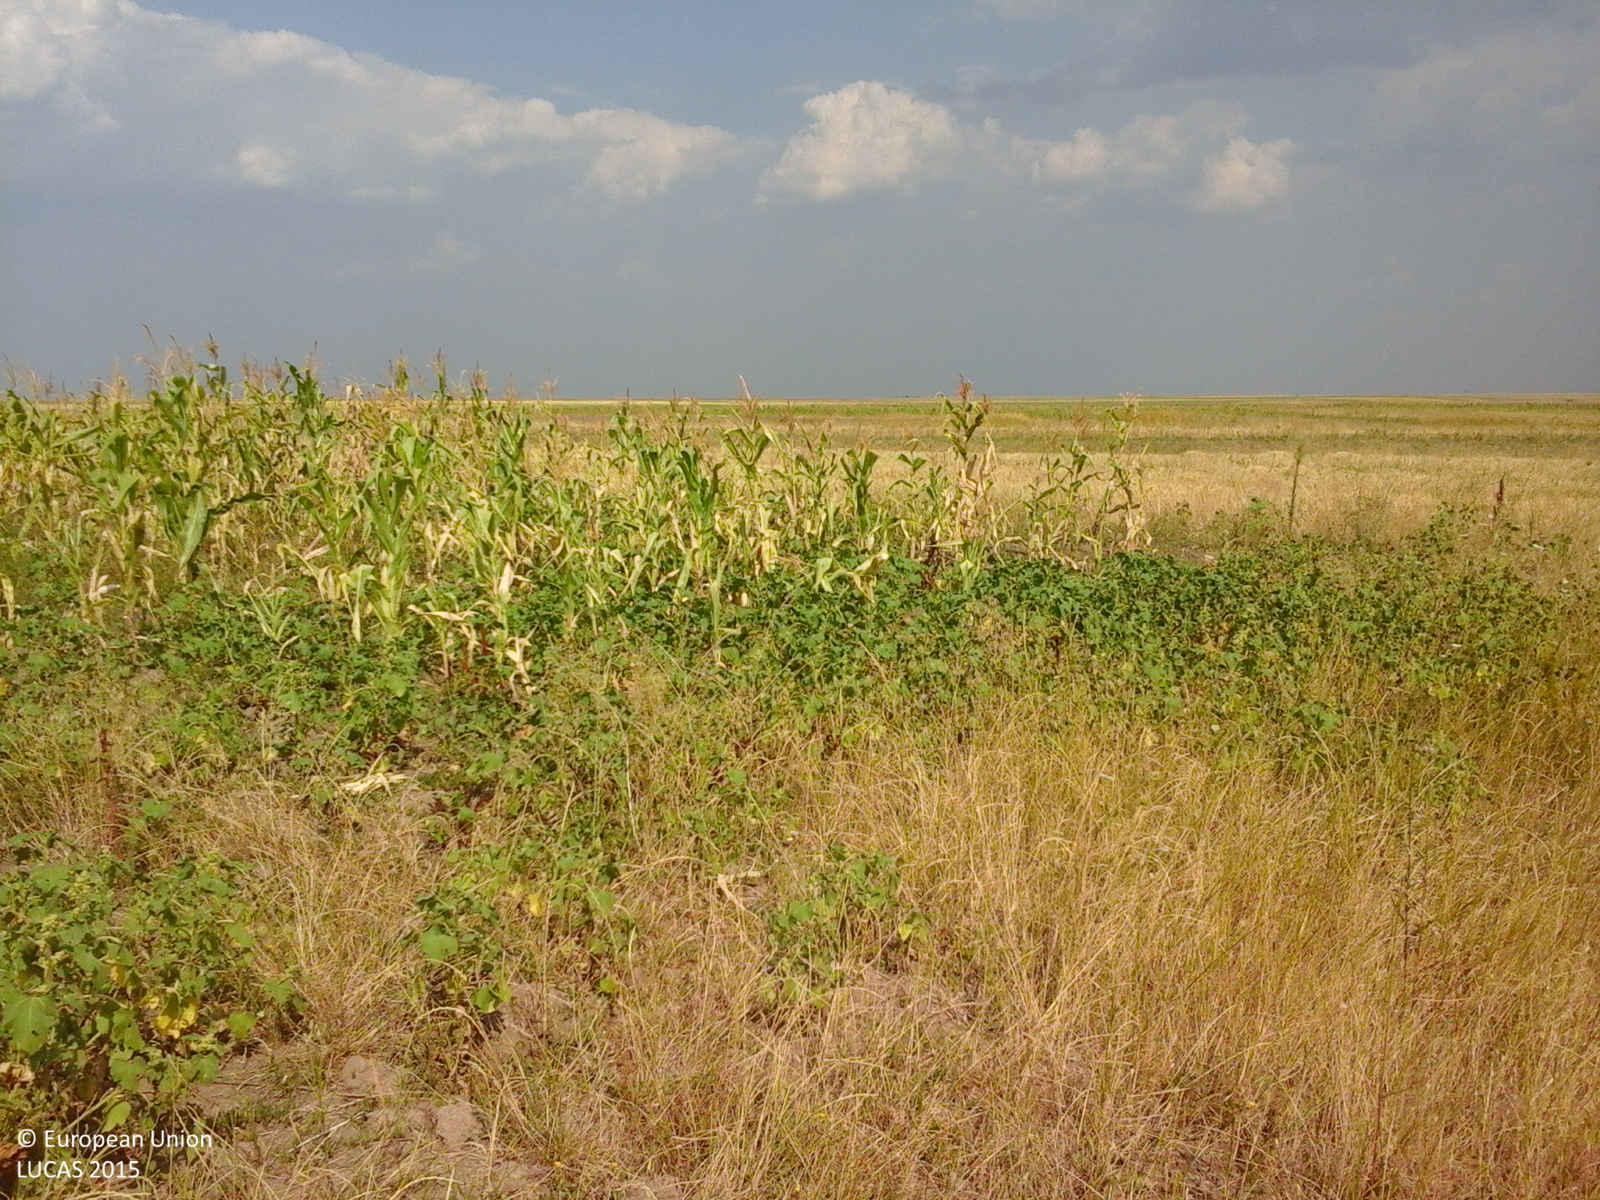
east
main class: Grassland
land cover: Spontaneously vegetated surfaces
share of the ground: > 75 %
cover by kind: herbaceous plants 100 %
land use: Fallow land
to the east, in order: Spontaneously vegetated surfaces; Maize; Common wheat; Other bare soil; Durum wheat; Tracks; Spontaneously vegetated surfaces; Common wheat; Other bare soil; Common wheat; Maize; Common wheat; Maize; Common wheat
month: August
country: RO
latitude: 44.4257
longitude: 23.1228
